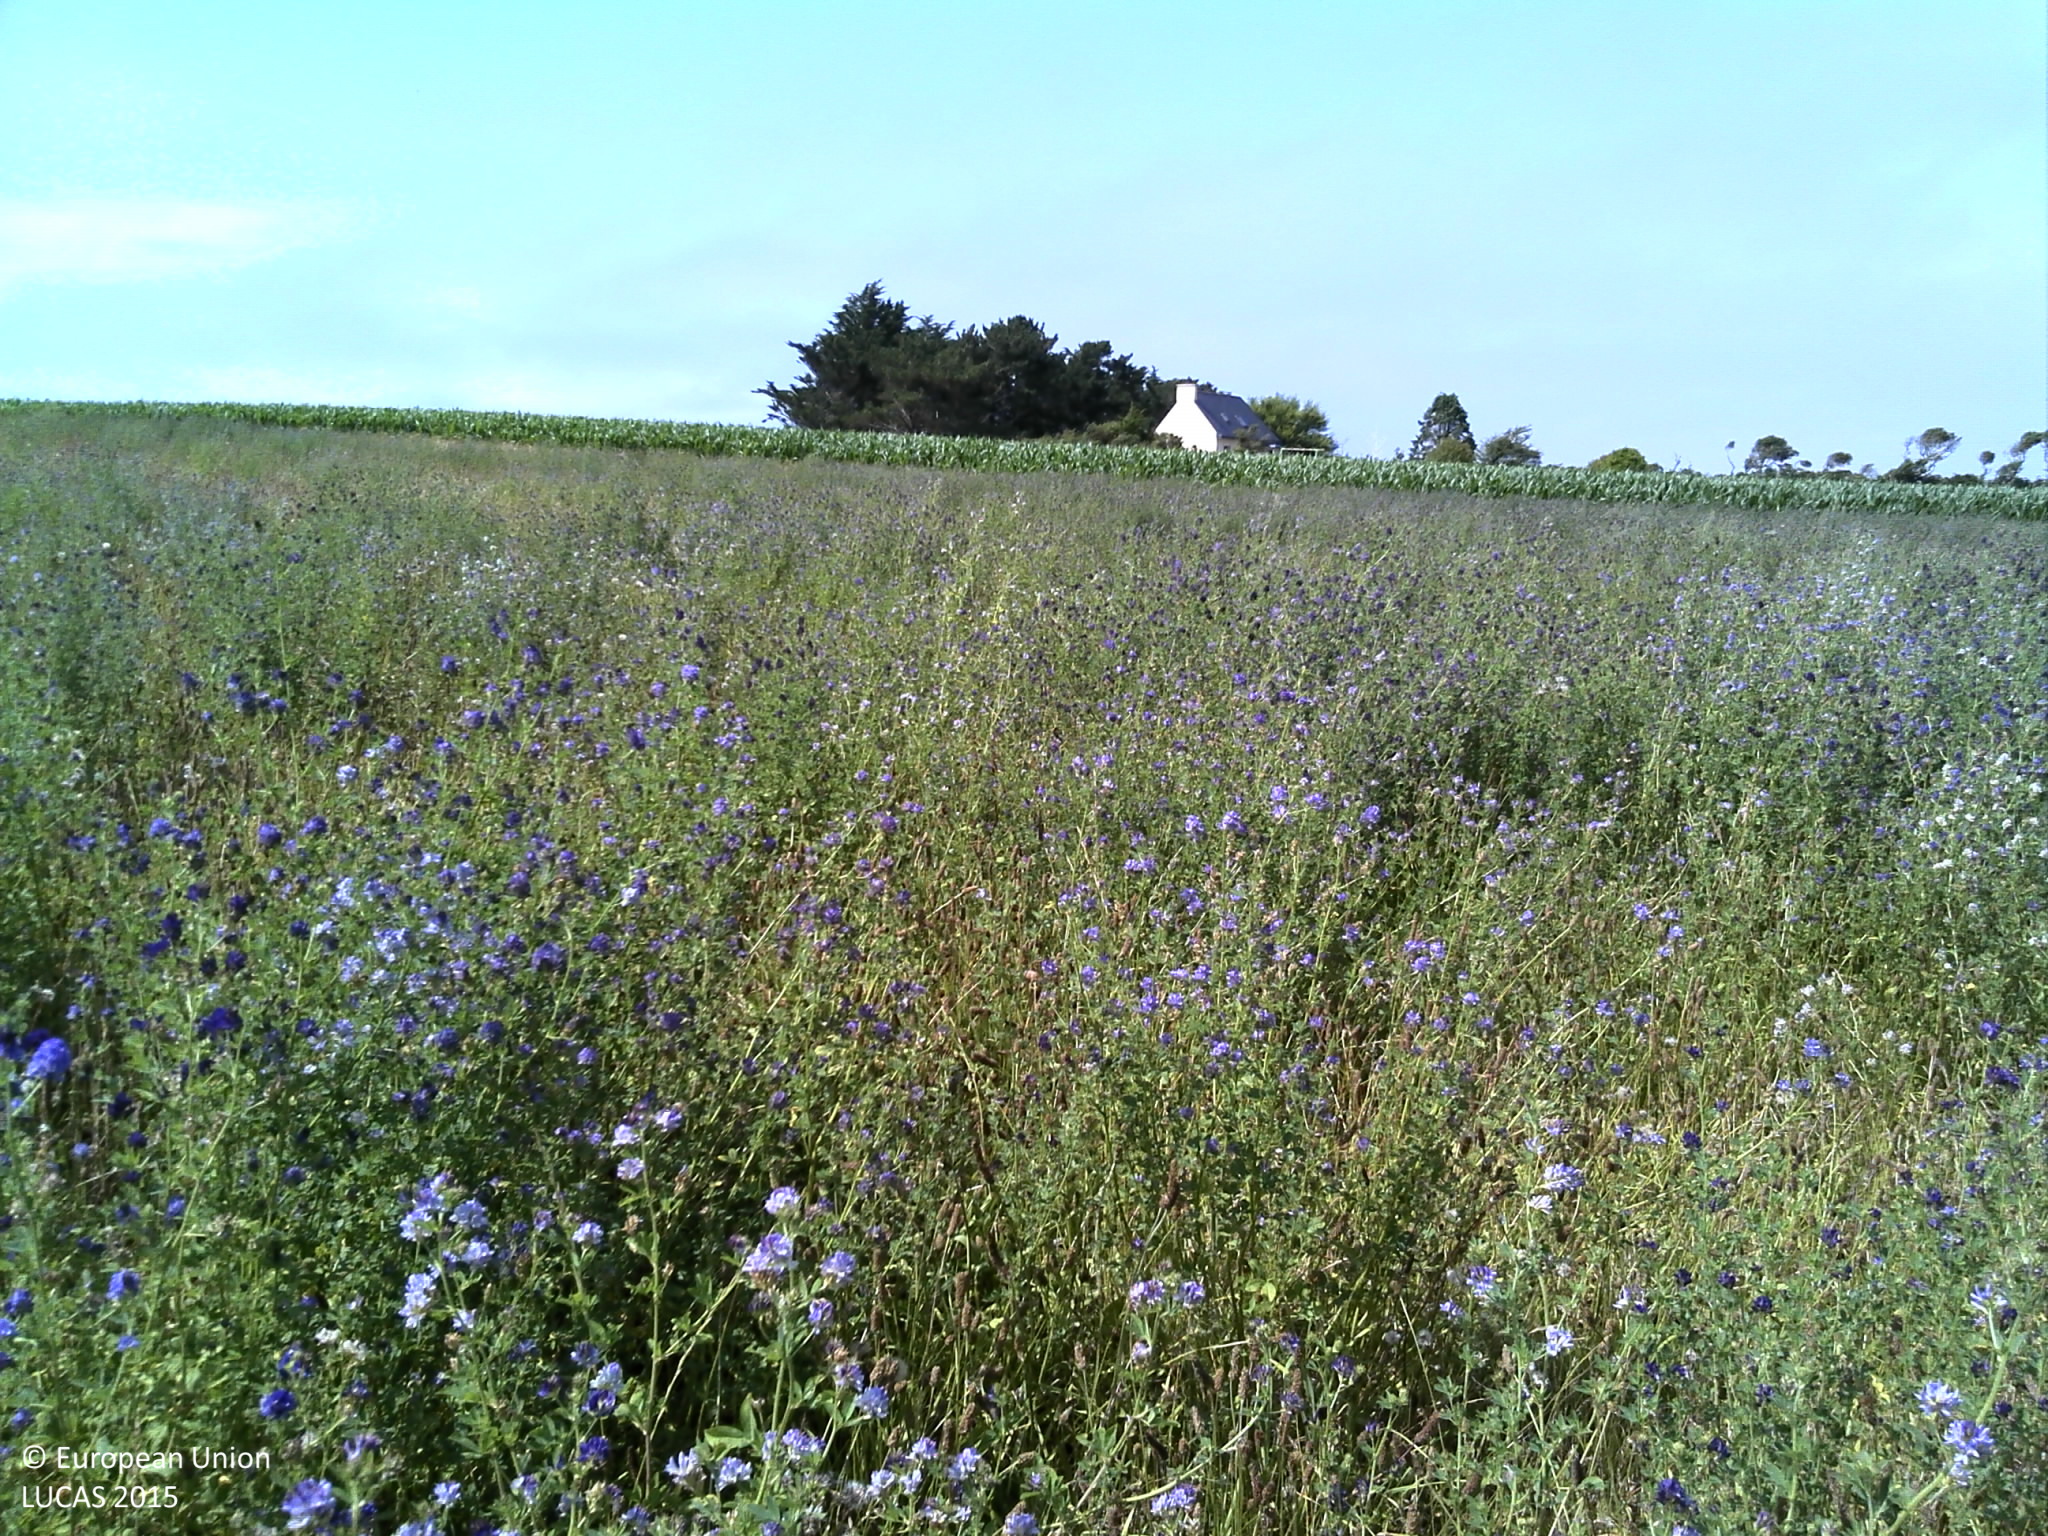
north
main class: Cropland
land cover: Lucerne
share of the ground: > 75 %
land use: Agriculture (excluding fallow land and kitchen gardens)
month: July
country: FR
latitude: 48.4290
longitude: -4.7683
